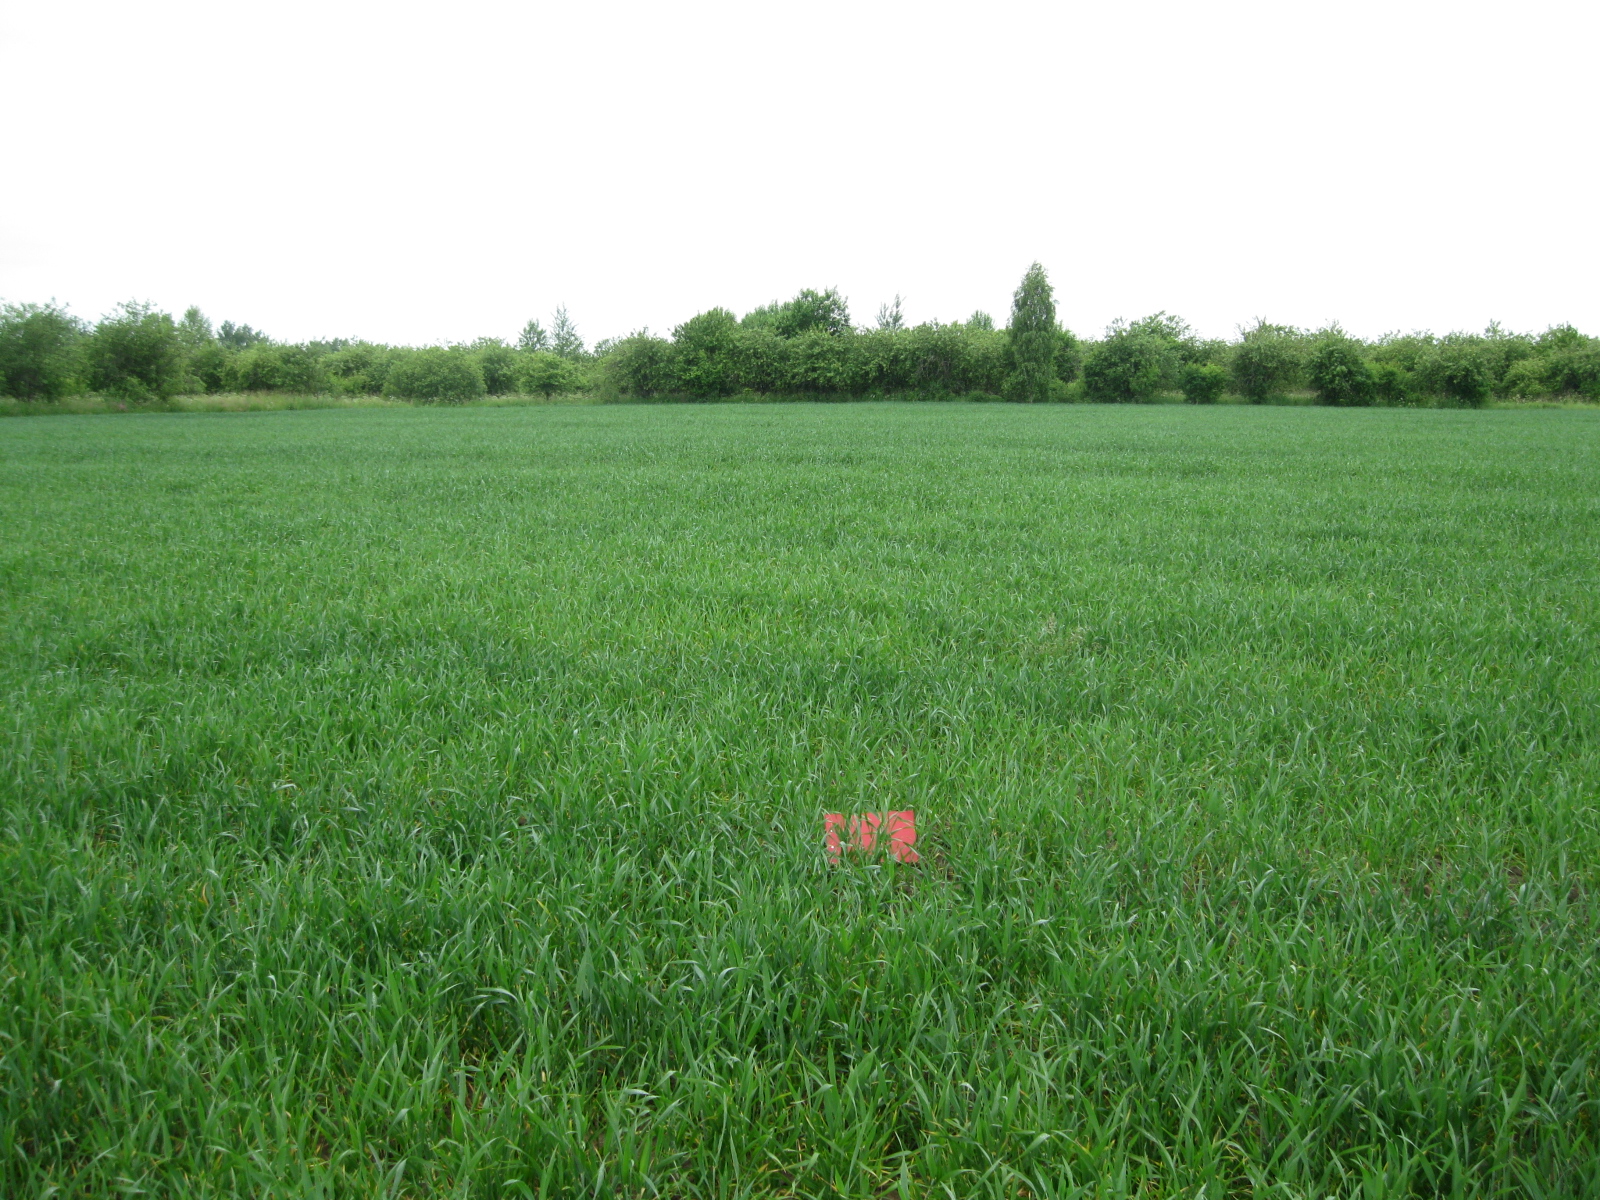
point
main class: Cropland
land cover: Common wheat
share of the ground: > 75 %
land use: Agriculture (excluding fallow land and kitchen gardens)
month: June
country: LT
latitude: 55.1684
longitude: 24.0797
